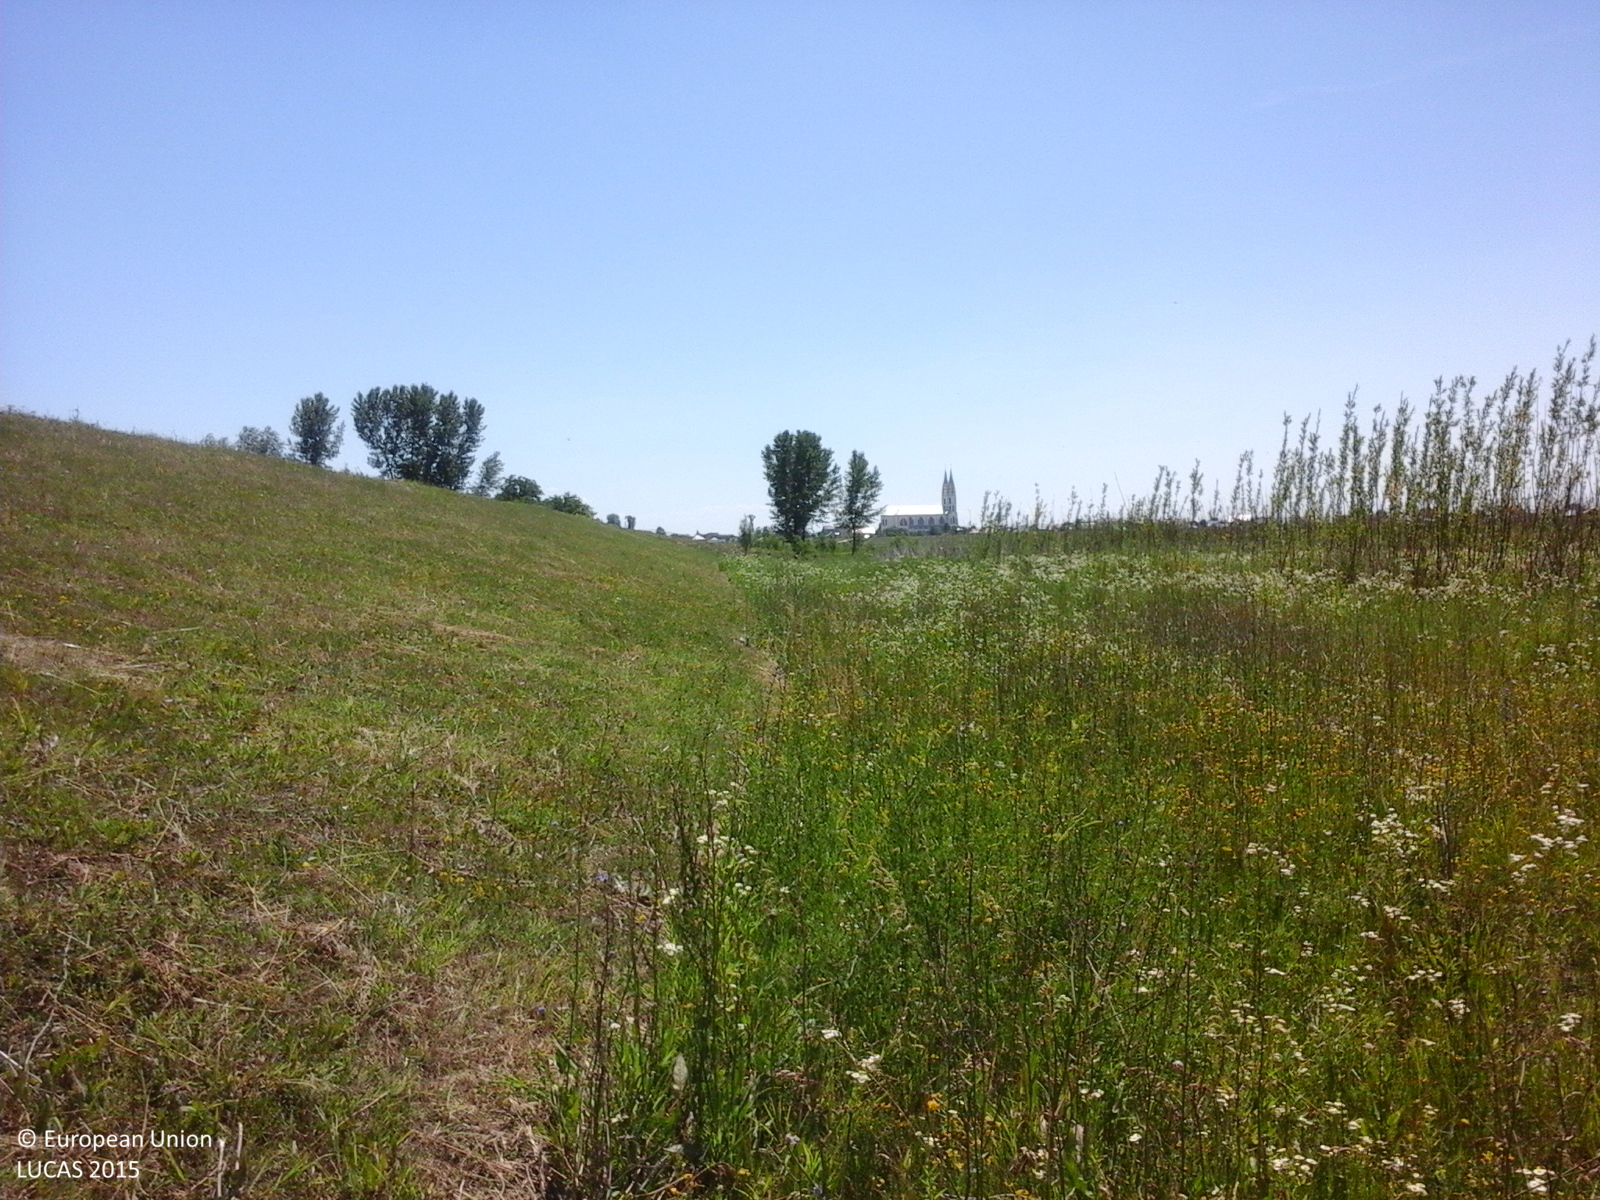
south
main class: Grassland
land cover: Grassland without tree/shrub cover
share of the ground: > 75 %
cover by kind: herbaceous plants 100 %
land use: Agriculture (excluding fallow land and kitchen gardens)
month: June
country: RO
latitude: 47.0262
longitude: 26.9533
